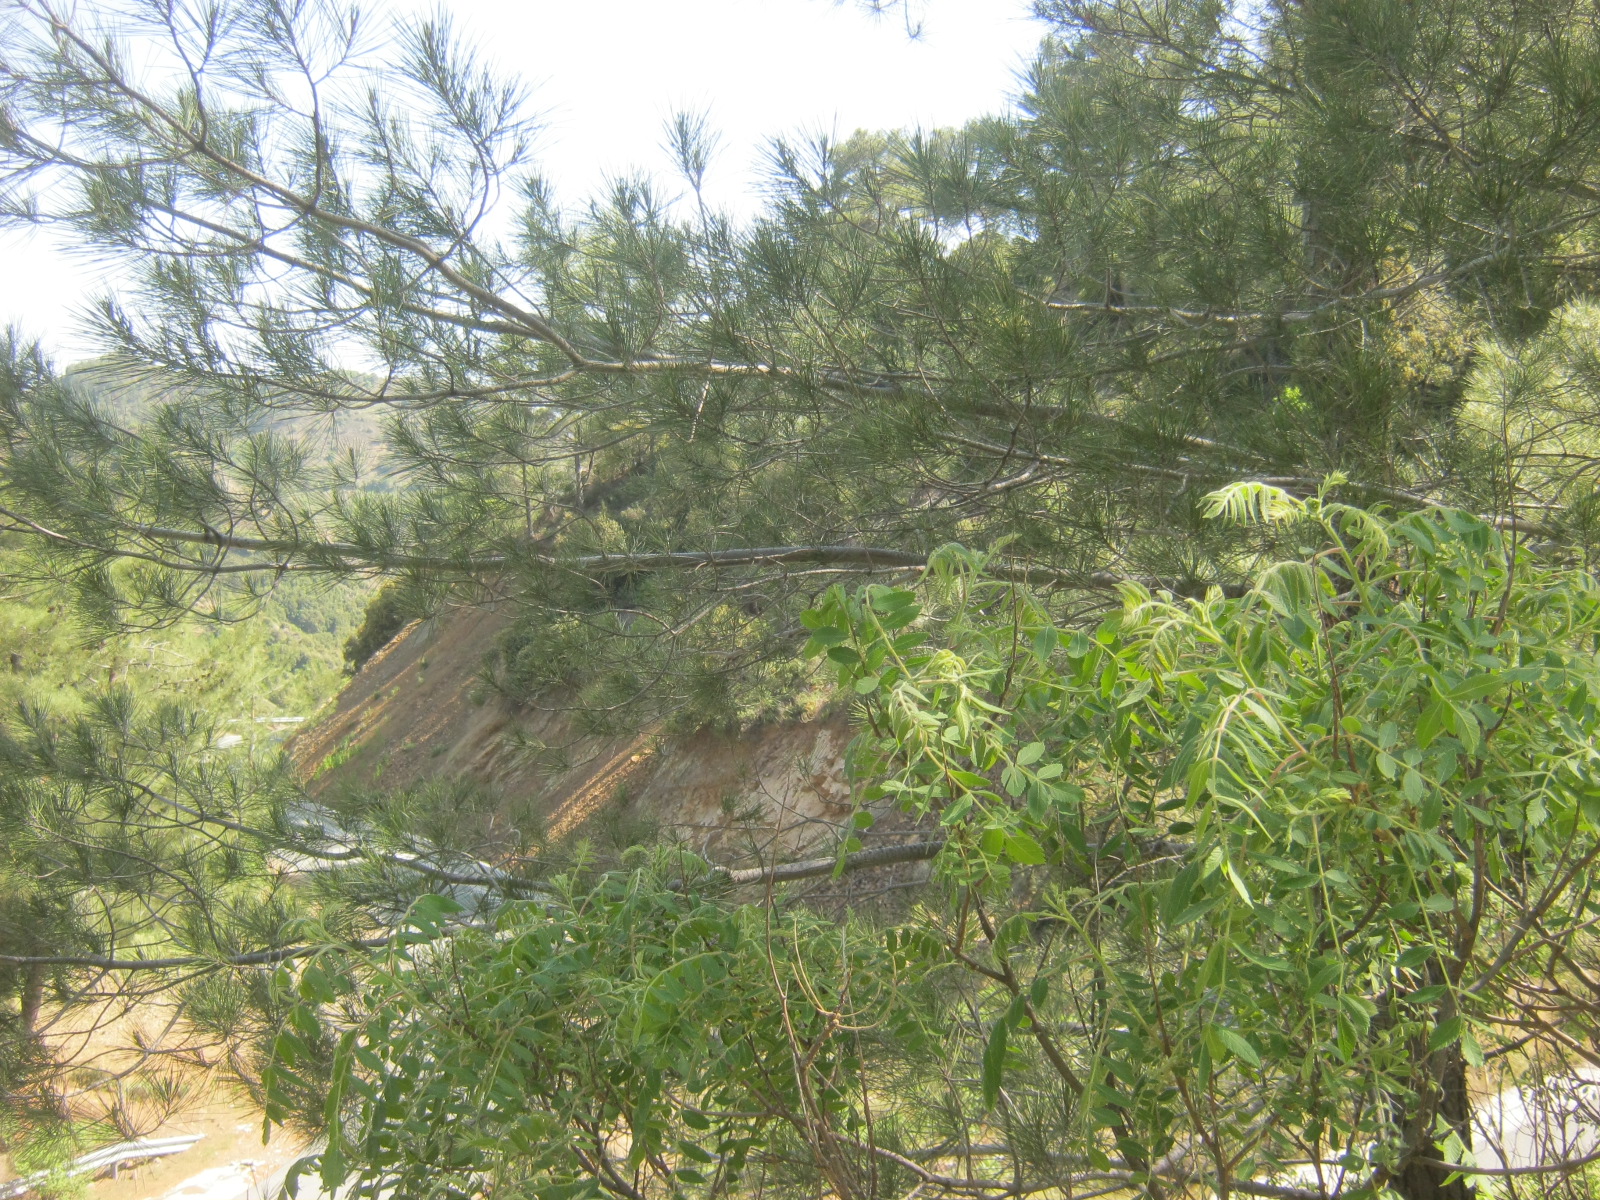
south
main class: Woodland
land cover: Pine dominated coniferous woodland
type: coniferous forest of the mediterranean region
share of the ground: 50 - 75 %
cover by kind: coniferous forest trees 50 %, unconsolidated bare surface 20 %, herbaceous plants 15 %, shrubs 10 %, broadleaved forest trees 5 %
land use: Semi-natural and natural areas not in use
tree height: > 5 m
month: May
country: CY
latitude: 34.9572
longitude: 32.8006
